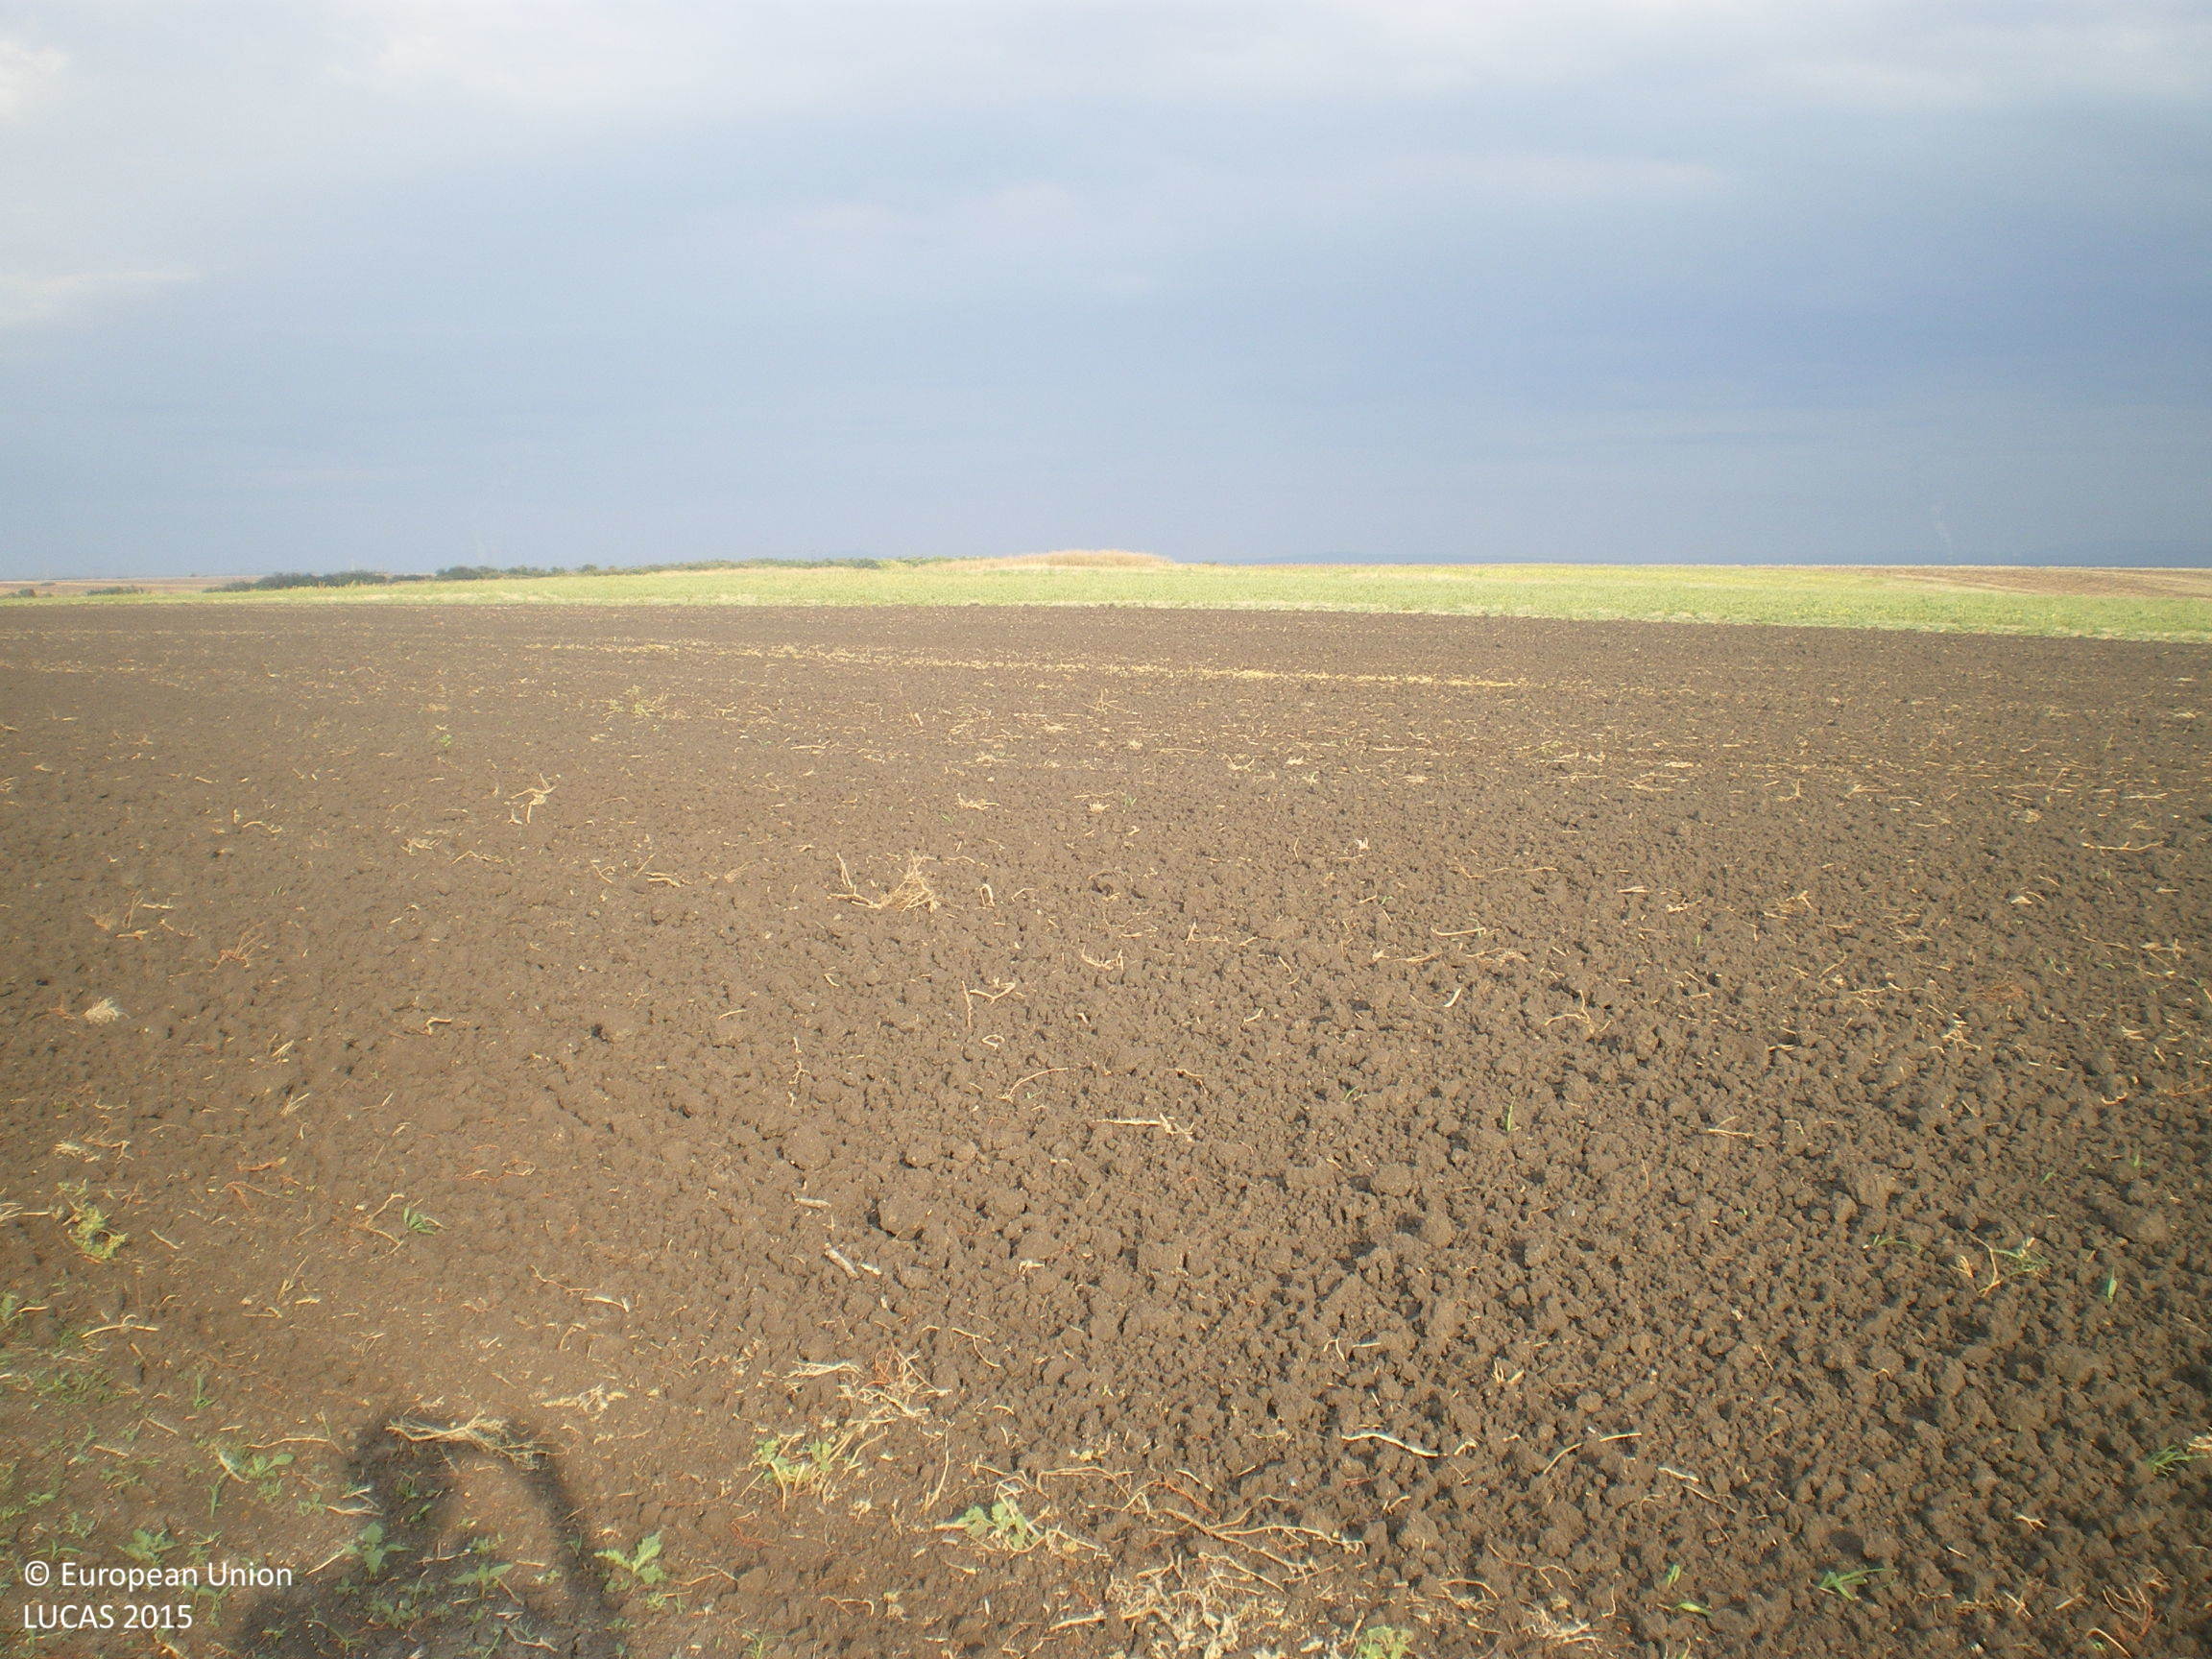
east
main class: Grassland
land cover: Spontaneously vegetated surfaces
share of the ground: 10 - 25 %
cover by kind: herbaceous plants 60 %, consolidated bare surface 40 %
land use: Agriculture (excluding fallow land and kitchen gardens)
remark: Harvested field
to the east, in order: Spontaneously vegetated surfaces; Sunflower
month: September
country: BG
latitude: 42.2117
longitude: 25.8078
